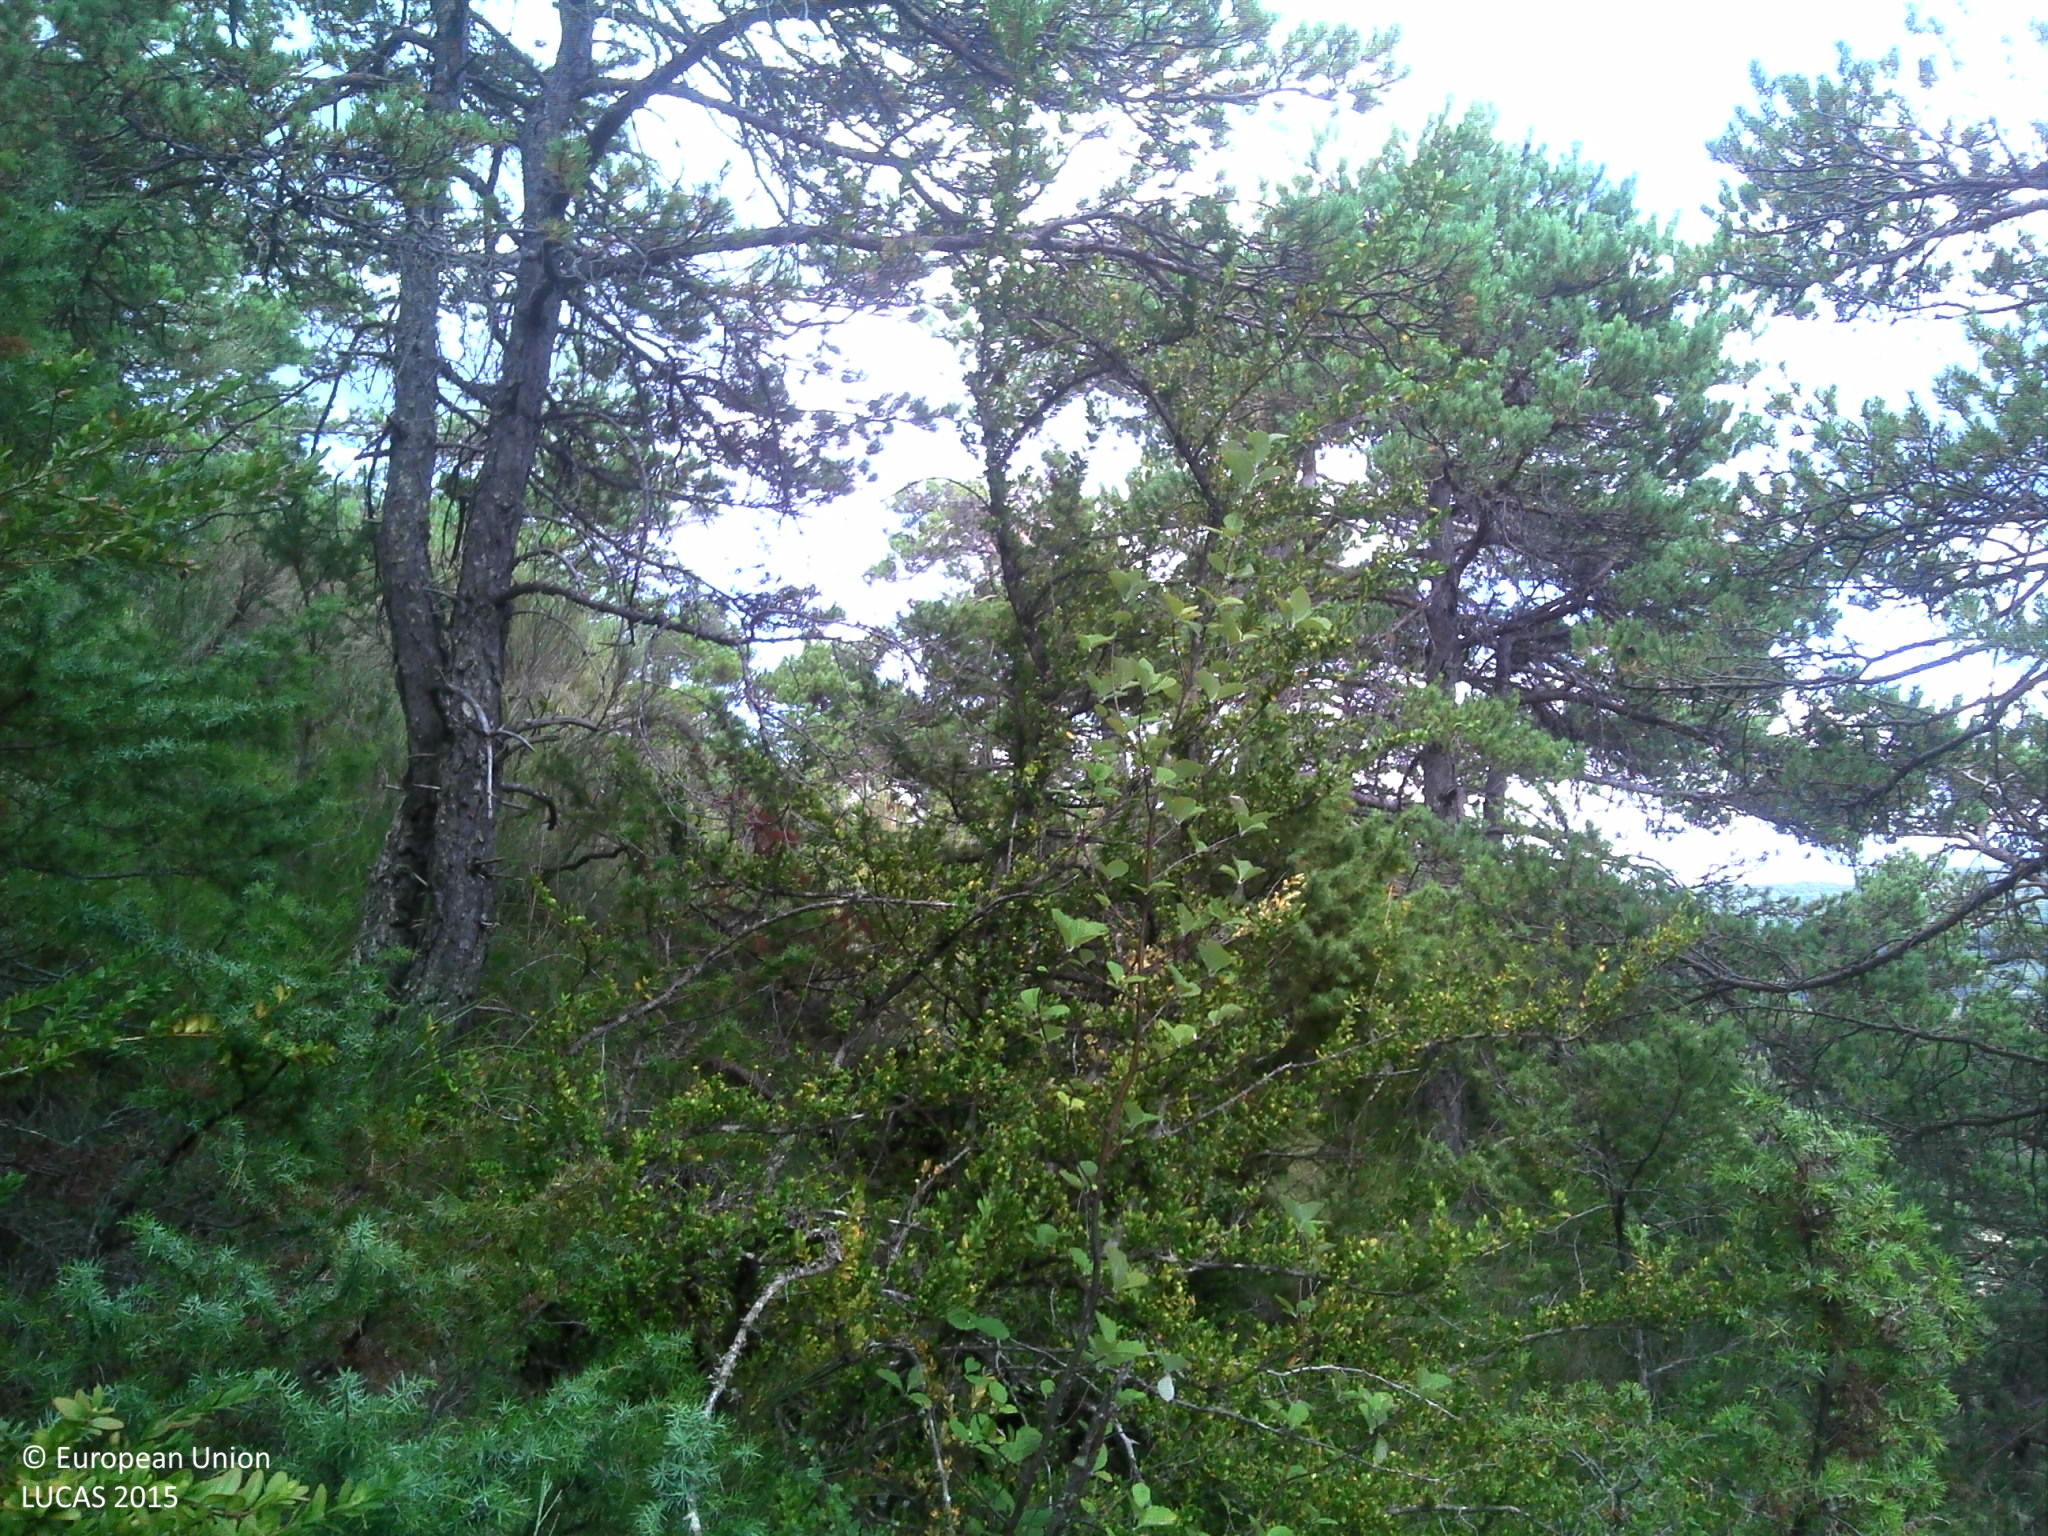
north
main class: Woodland
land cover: Pine dominated coniferous woodland
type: coniferous forest of the mediterranean region
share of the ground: > 75 %
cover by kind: coniferous forest trees 65 %, herbaceous plants 30 %, broadleaved forest trees 5 %
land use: Semi-natural and natural areas not in use
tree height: > 5 m
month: September
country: FR
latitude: 44.5382
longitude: 5.4133
